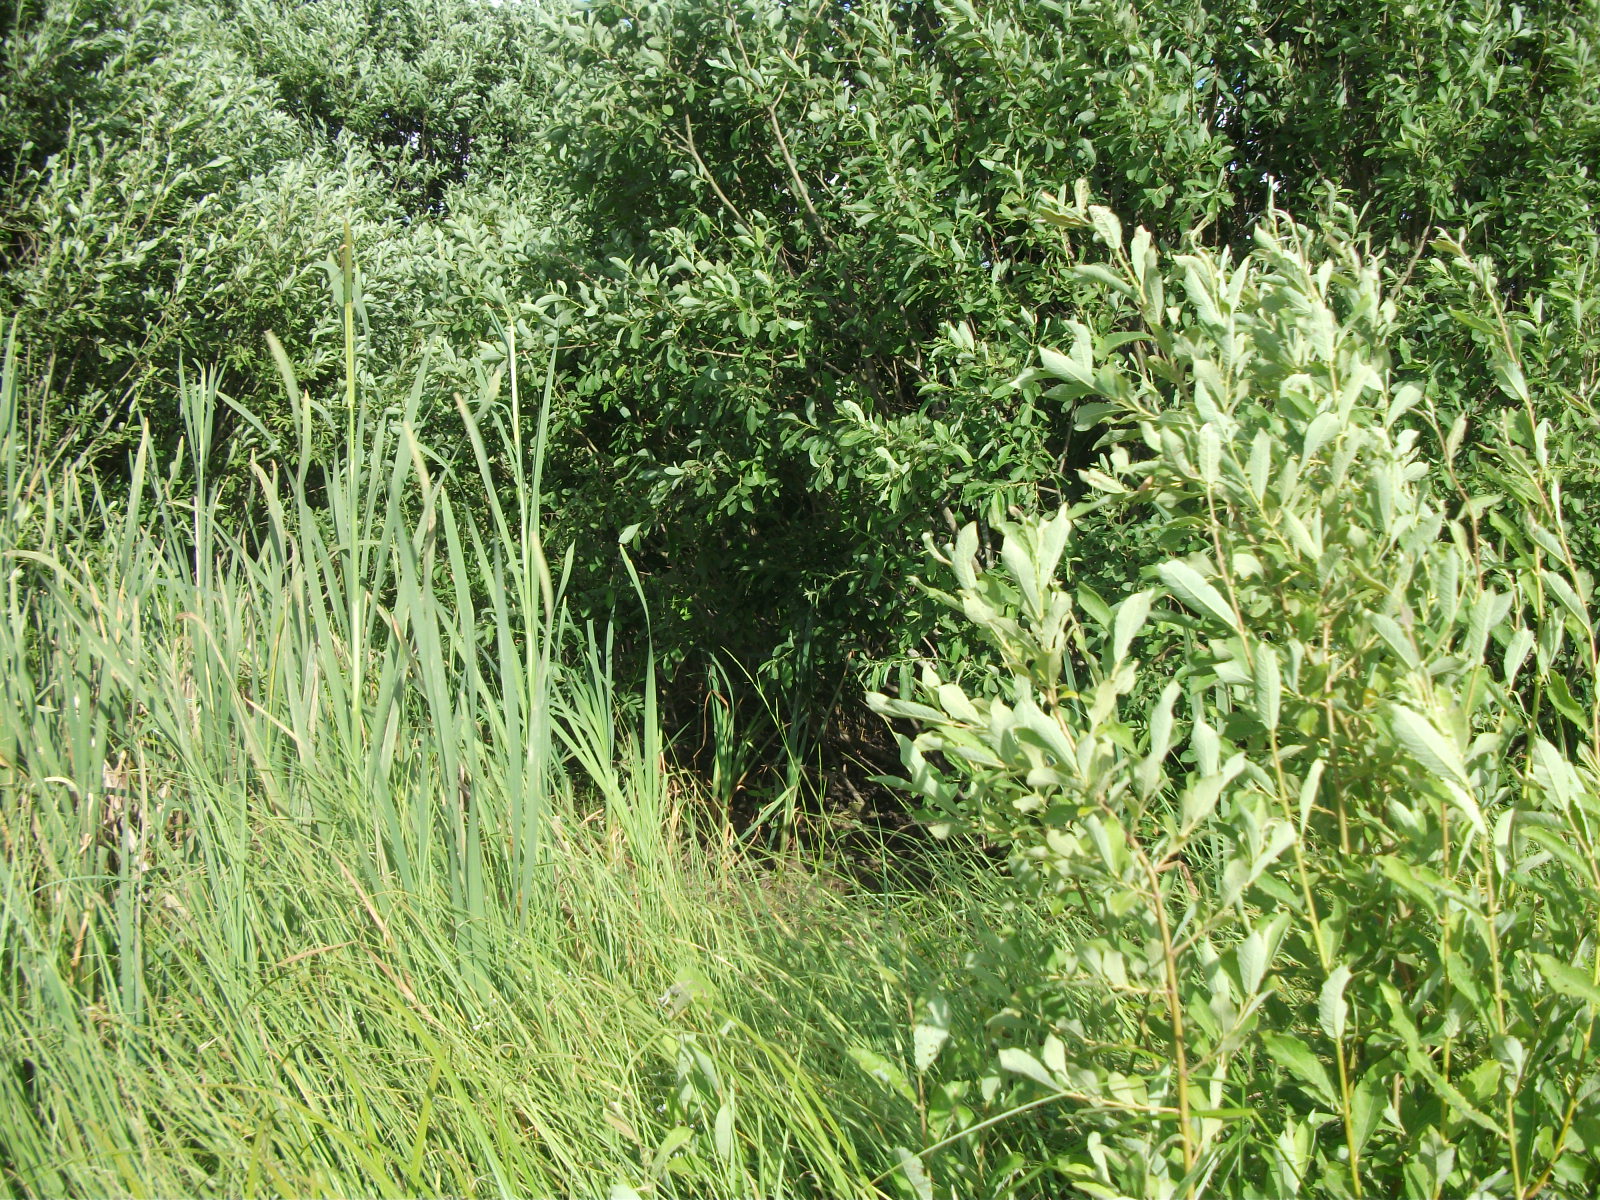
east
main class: Woodland
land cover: Broadleaved woodland
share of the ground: 50 - 75 %
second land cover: Spontaneously vegetated surfaces
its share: 50 - 75 %
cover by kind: broadleaved forest trees 50 %, shrubs 30 %, herbaceous plants 20 %
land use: Agriculture (excluding fallow land and kitchen gardens)
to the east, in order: Broadleaved woodland; Spontaneously vegetated surfaces; Shrubland without tree cover; Grassland without tree/shrub cover; Broadleaved woodland; Grassland without tree/shrub cover; Broadleaved woodland
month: July
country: LV
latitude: 57.1650
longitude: 25.9539
